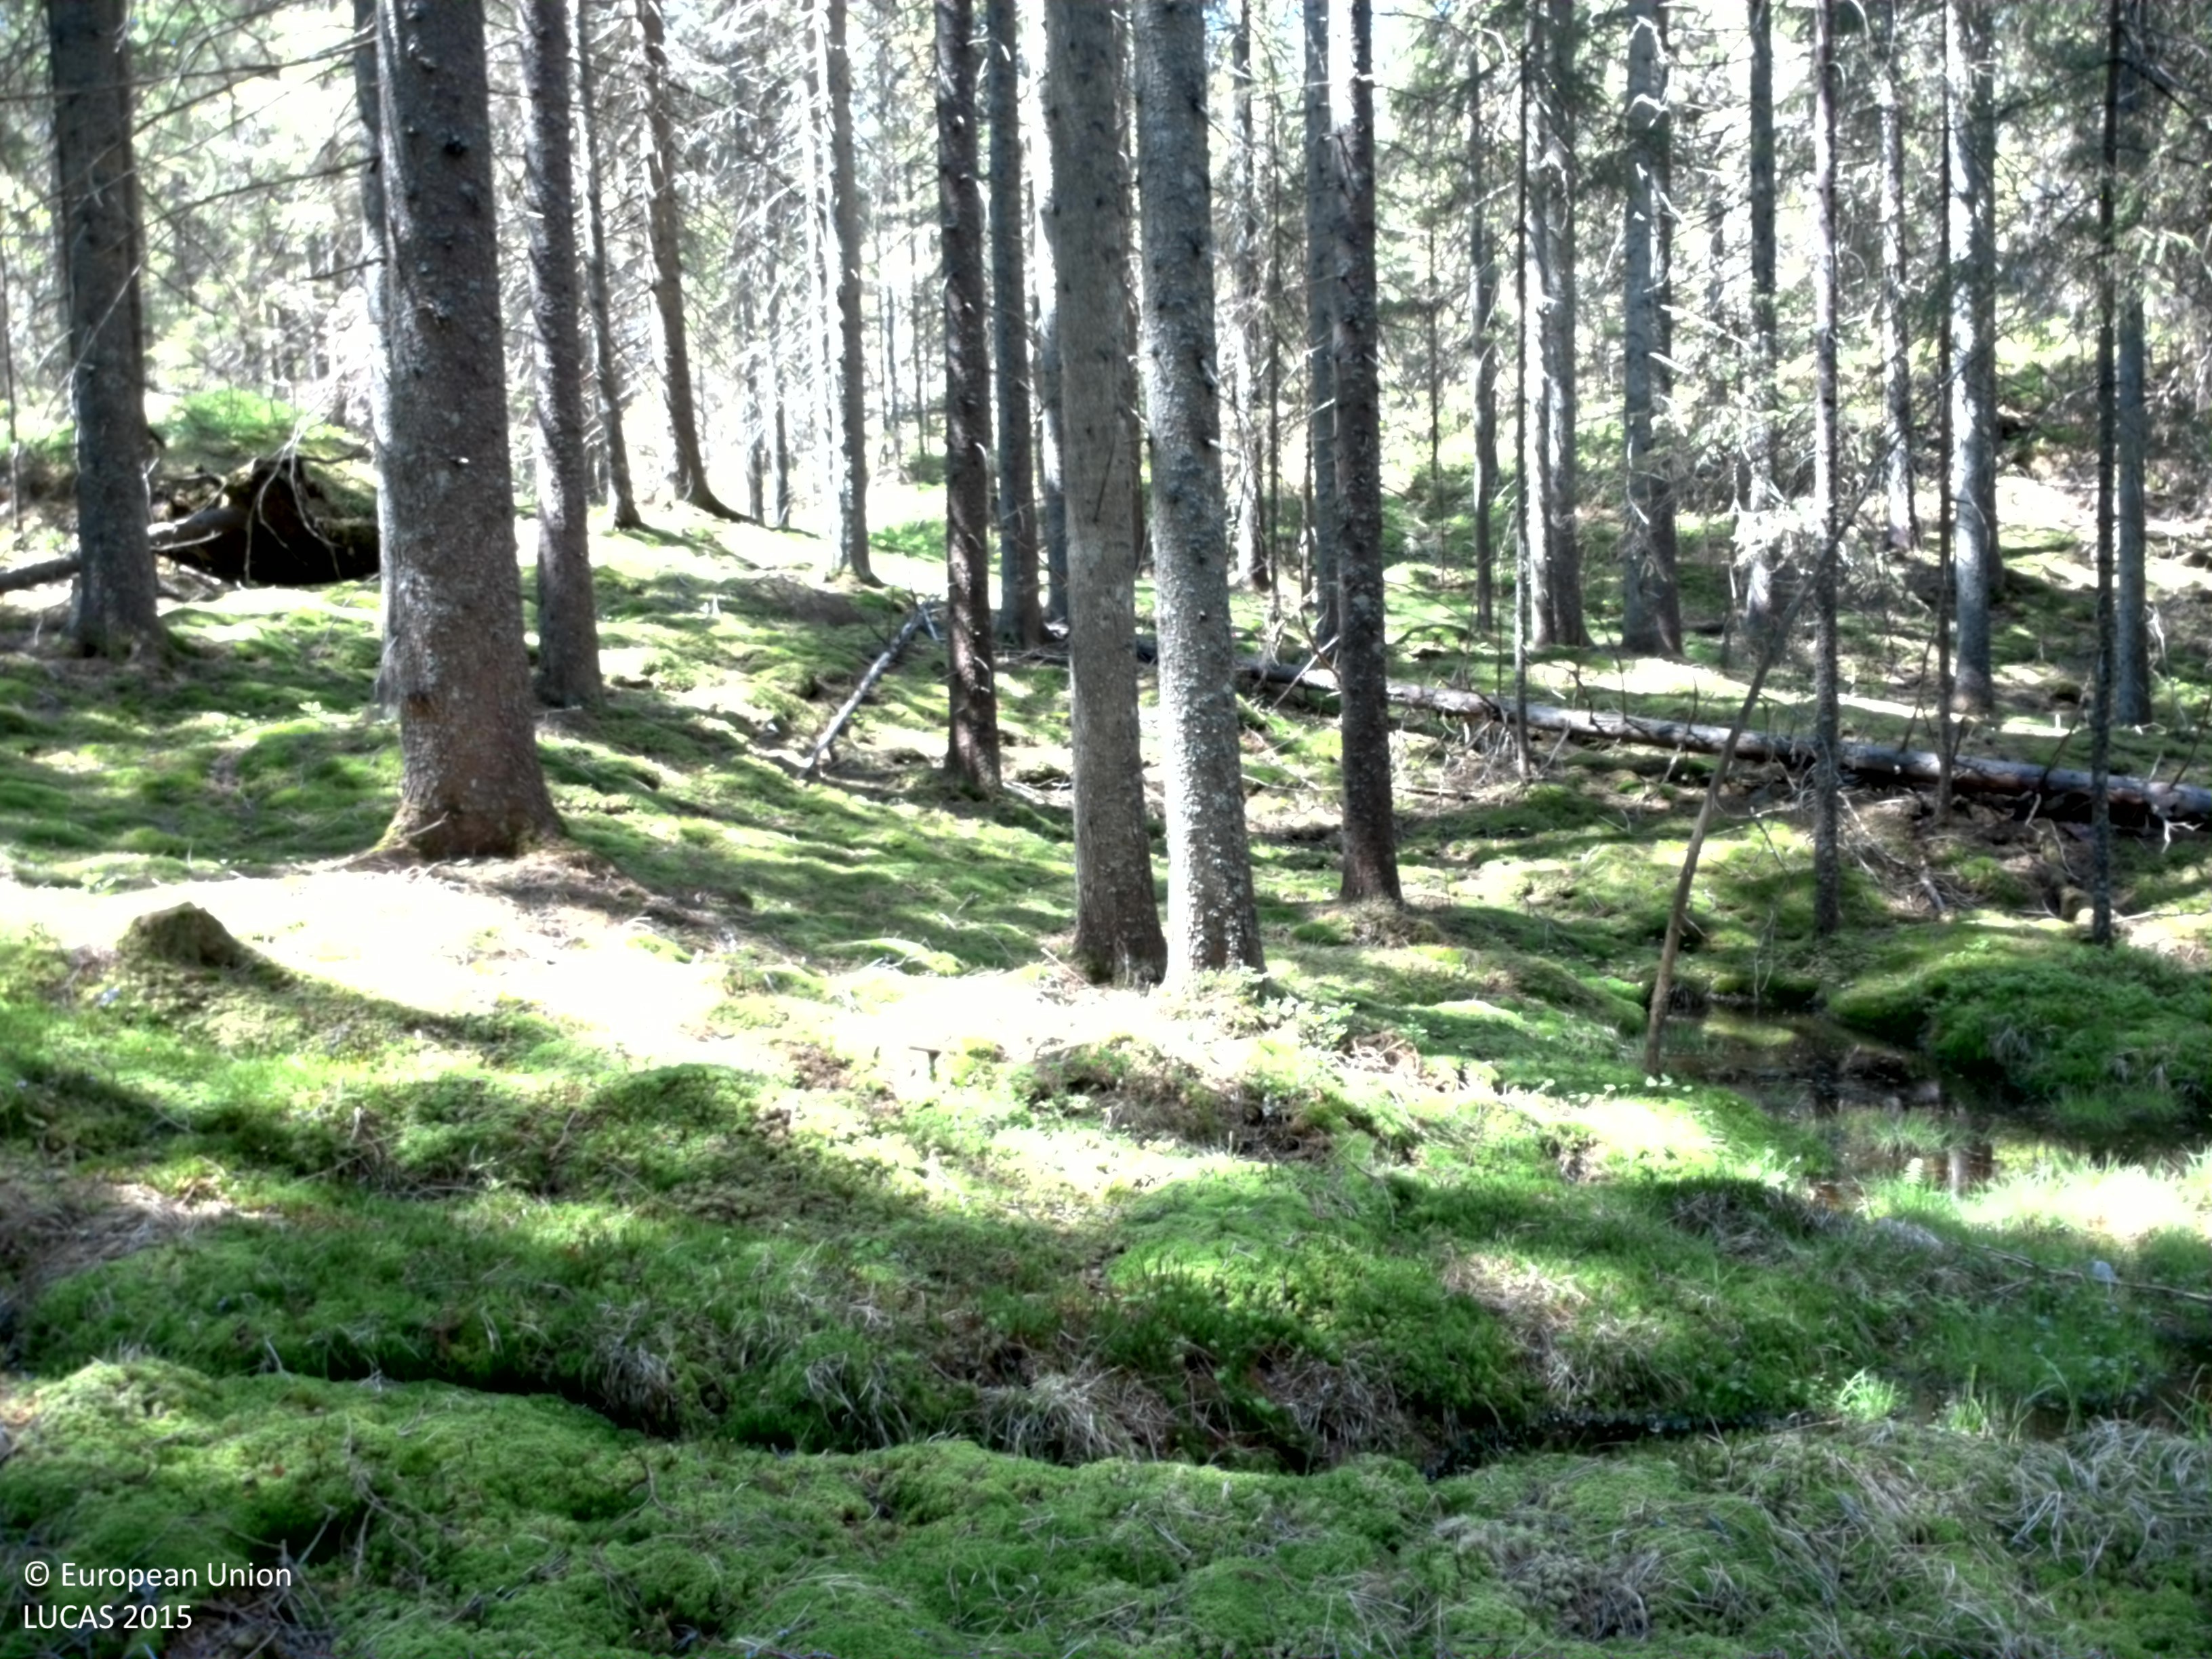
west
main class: Woodland
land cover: Spruce dominated coniferous woodland
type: boreal forest
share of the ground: > 75 %
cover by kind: coniferous forest trees 80 %, lichens and mosses 15 %, shrubs 5 %
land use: Forestry
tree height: > 5 m
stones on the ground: 10 - 25 %
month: June
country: SE
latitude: 59.3865
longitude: 12.3708
